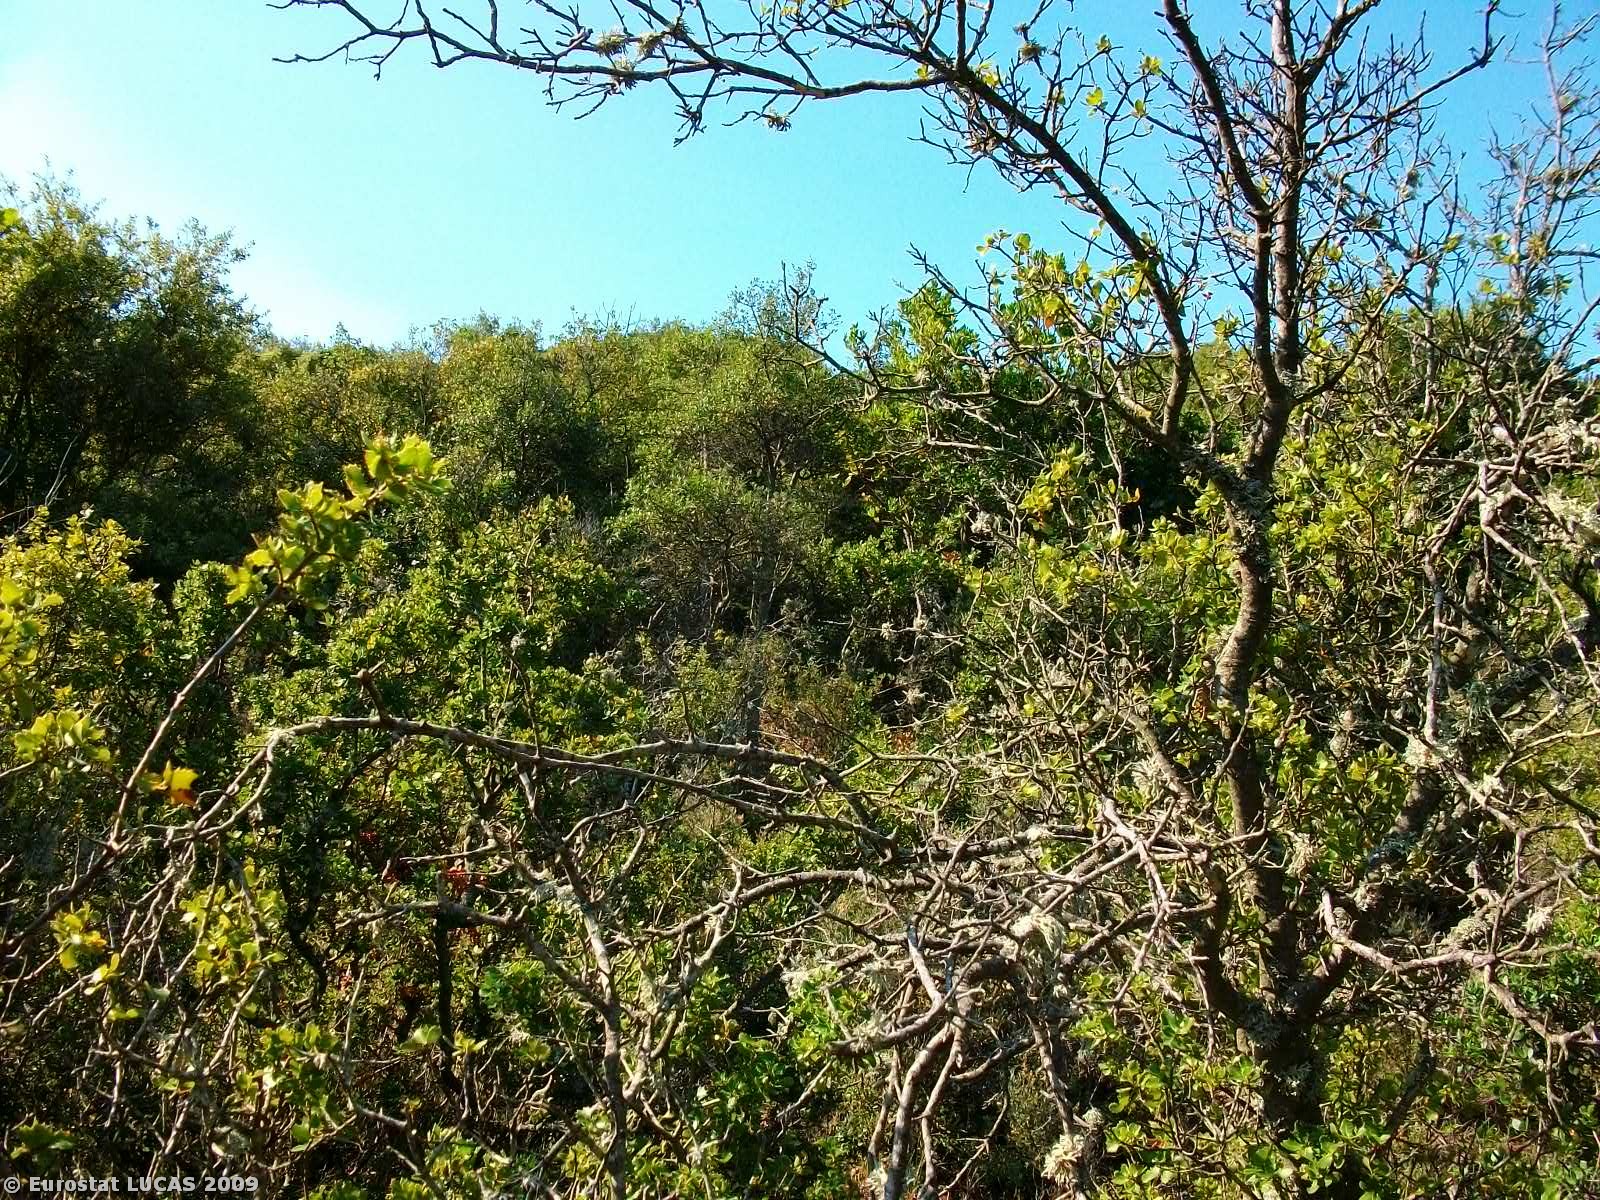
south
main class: Woodland
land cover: Broadleaved woodland
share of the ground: > 75 %
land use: Forestry
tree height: < 5 m
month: July
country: GR
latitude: 40.7557
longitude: 24.0354
